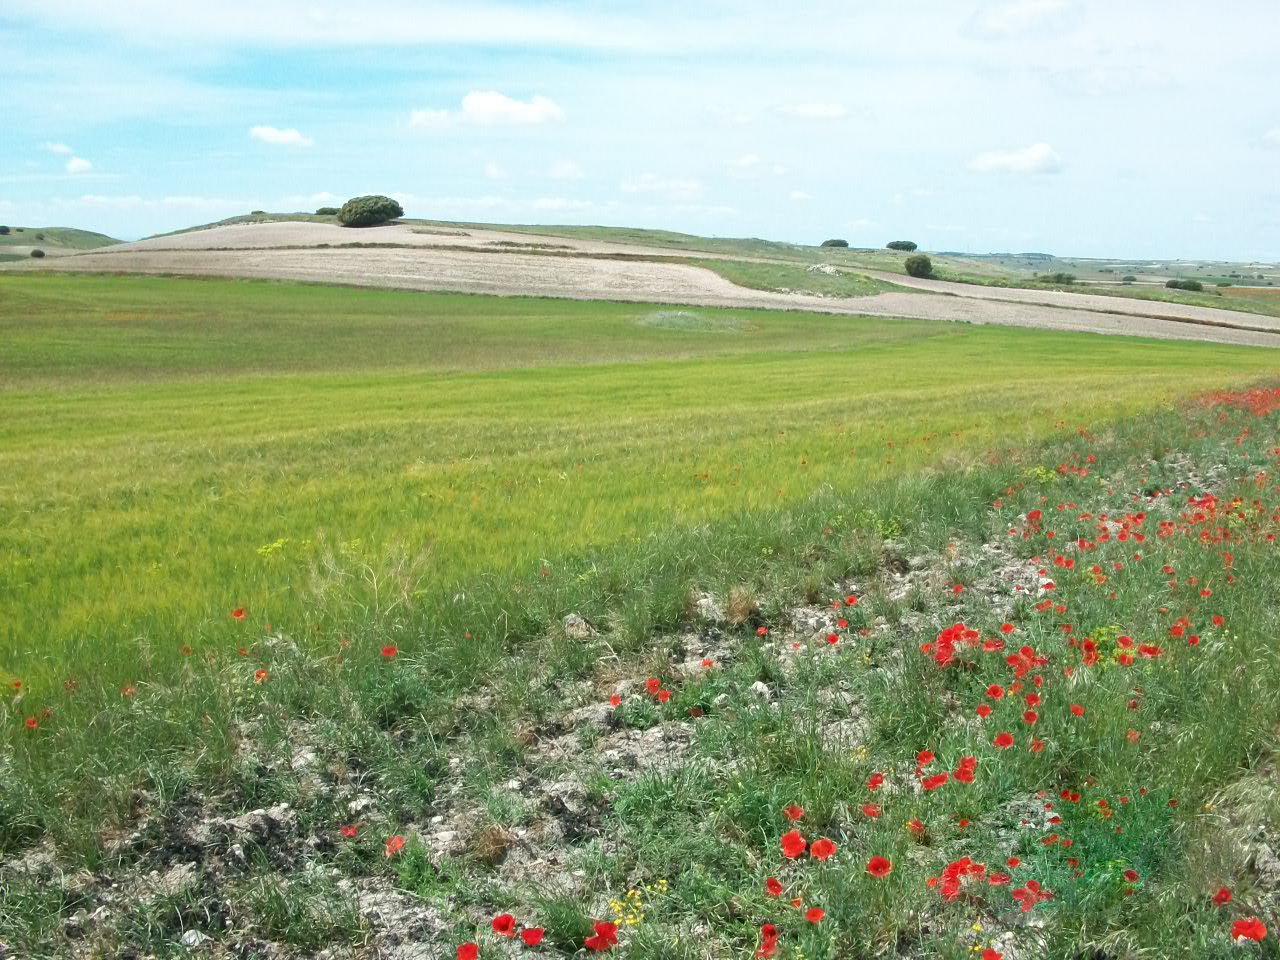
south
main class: Grassland
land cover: Spontaneously vegetated surfaces
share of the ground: > 75 %
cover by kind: herbaceous plants 80 %, unconsolidated bare surface 20 %
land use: Fallow land
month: May
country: ES
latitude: 40.1461
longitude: -3.6854
